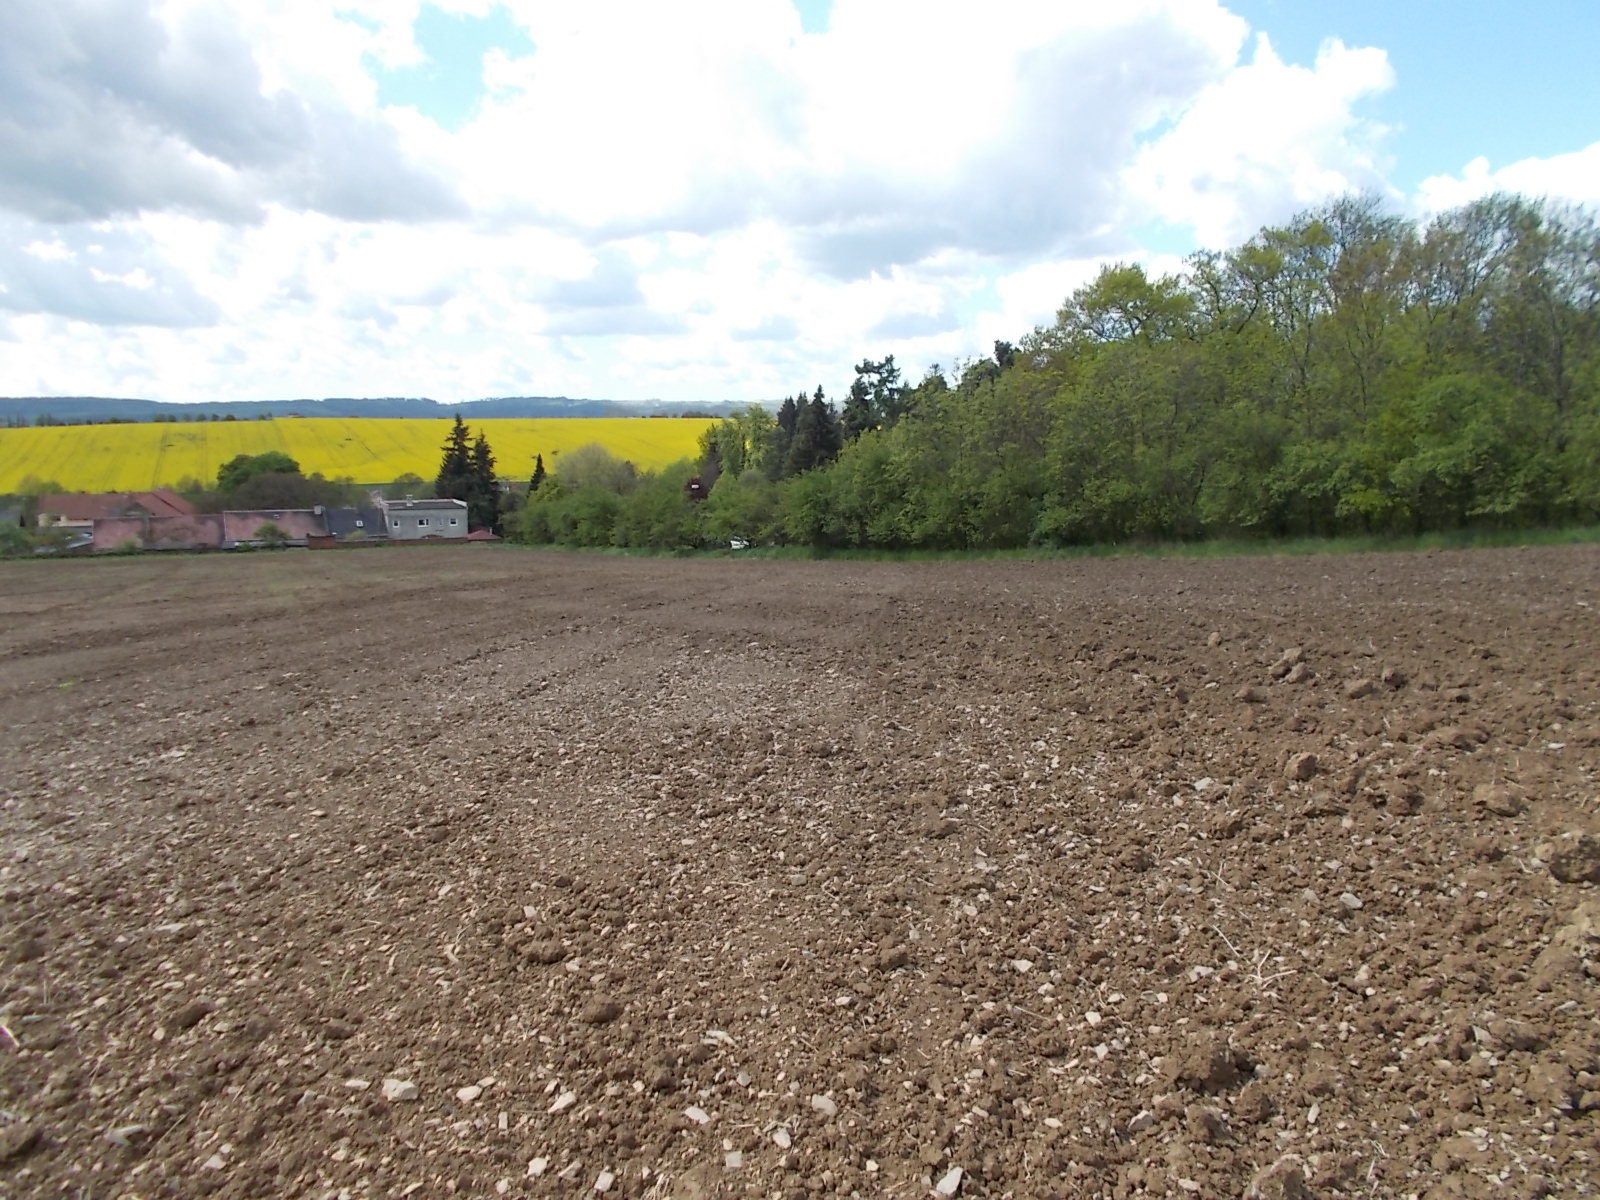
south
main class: Cropland
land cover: Common wheat
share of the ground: < 10 %
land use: Agriculture (excluding fallow land and kitchen gardens)
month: May
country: CZ
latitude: 49.9366
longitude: 17.7745
